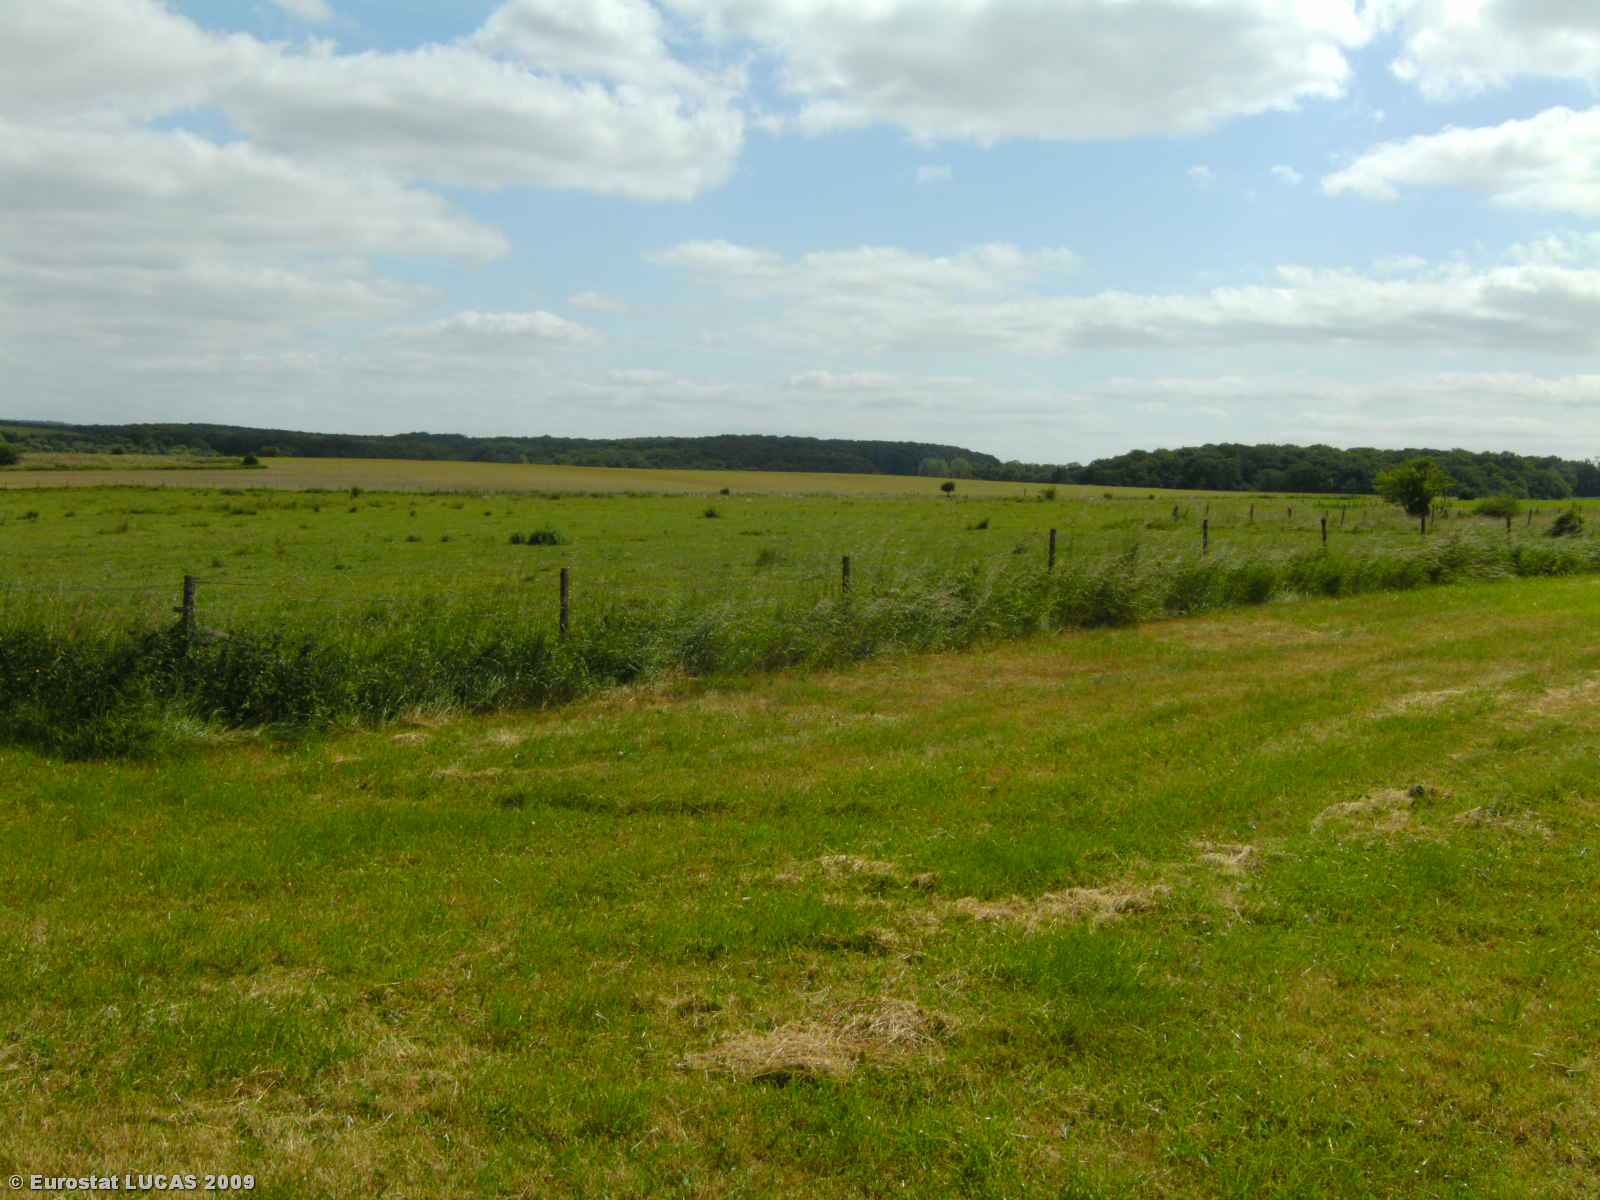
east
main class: Grassland
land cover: Grassland without tree/shrub cover
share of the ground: > 75 %
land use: Agriculture (excluding fallow land and kitchen gardens)
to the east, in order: Grassland without tree/shrub cover; Fences; Grassland without tree/shrub cover; Fences; Grassland without tree/shrub cover; Fences; Grassland without tree/shrub cover; Fences; Grassland without tree/shrub cover
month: June
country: LU
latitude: 49.6194
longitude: 6.2761
